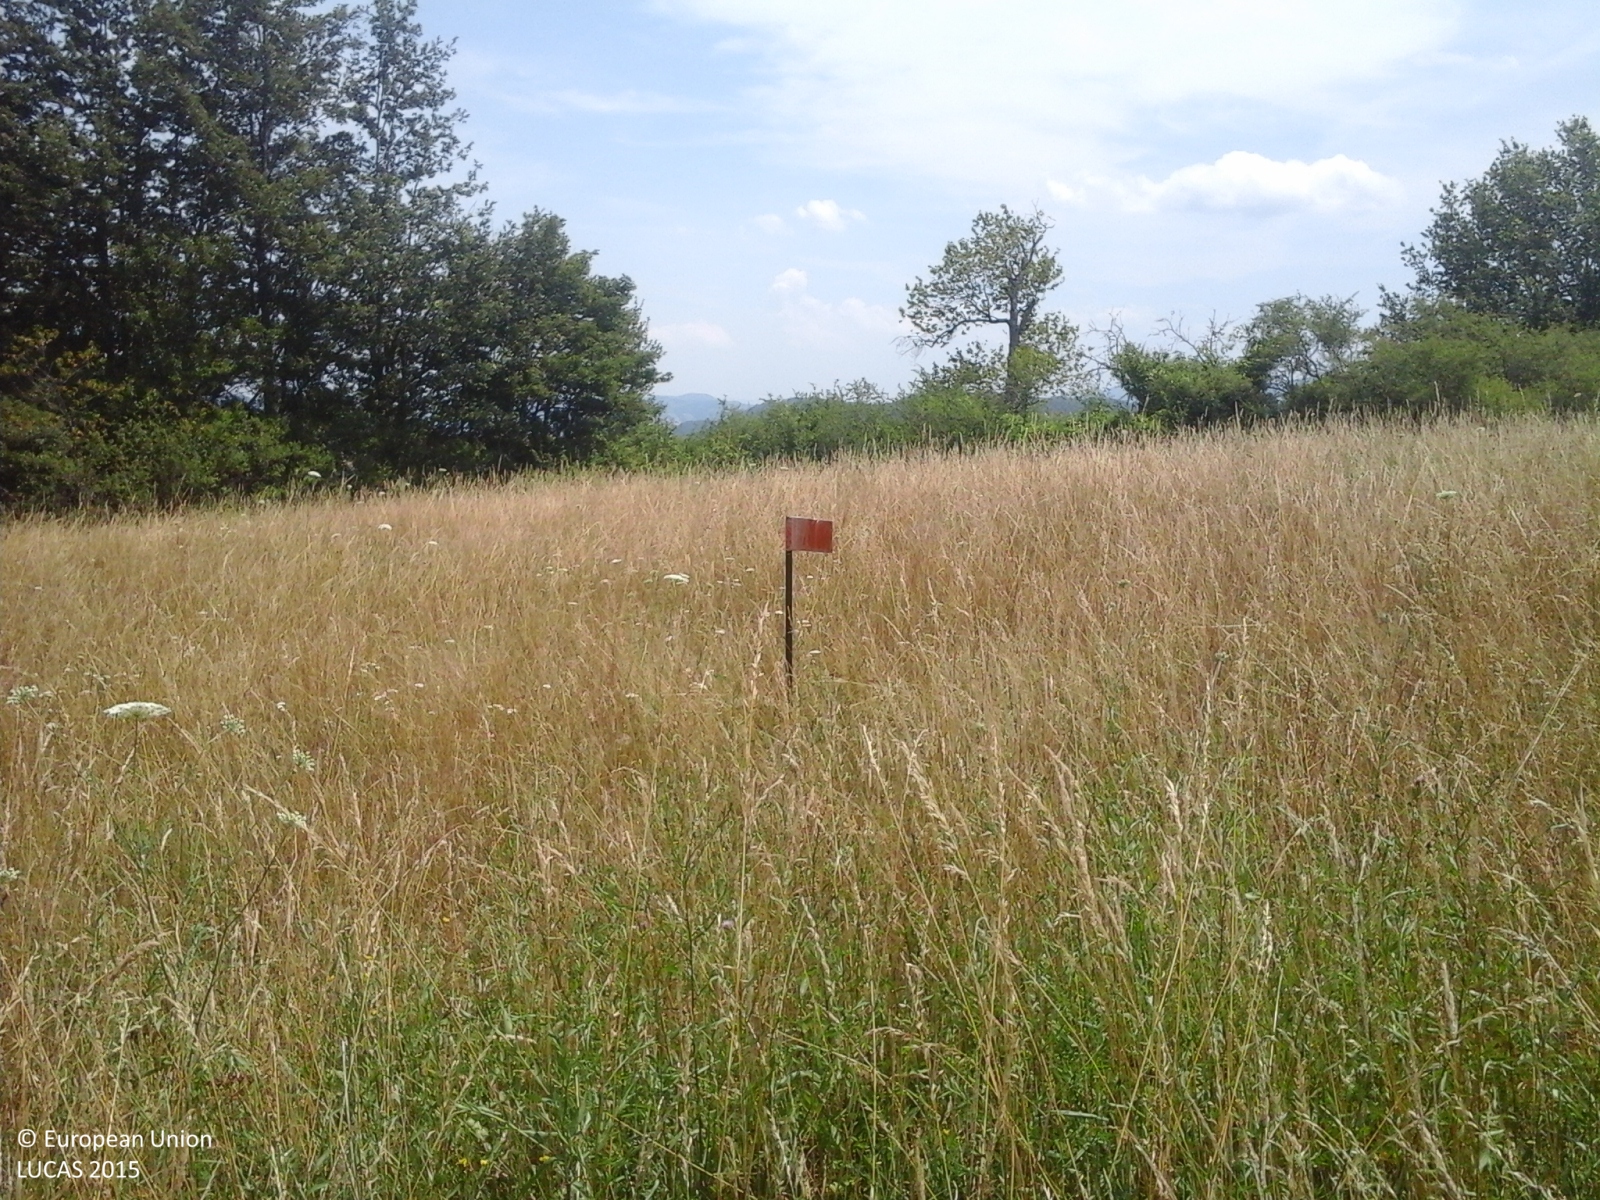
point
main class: Grassland
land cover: Grassland without tree/shrub cover
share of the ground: > 75 %
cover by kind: herbaceous plants 100 %
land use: Agriculture (excluding fallow land and kitchen gardens)
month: July
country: IT
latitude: 44.3861
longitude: 10.3381
